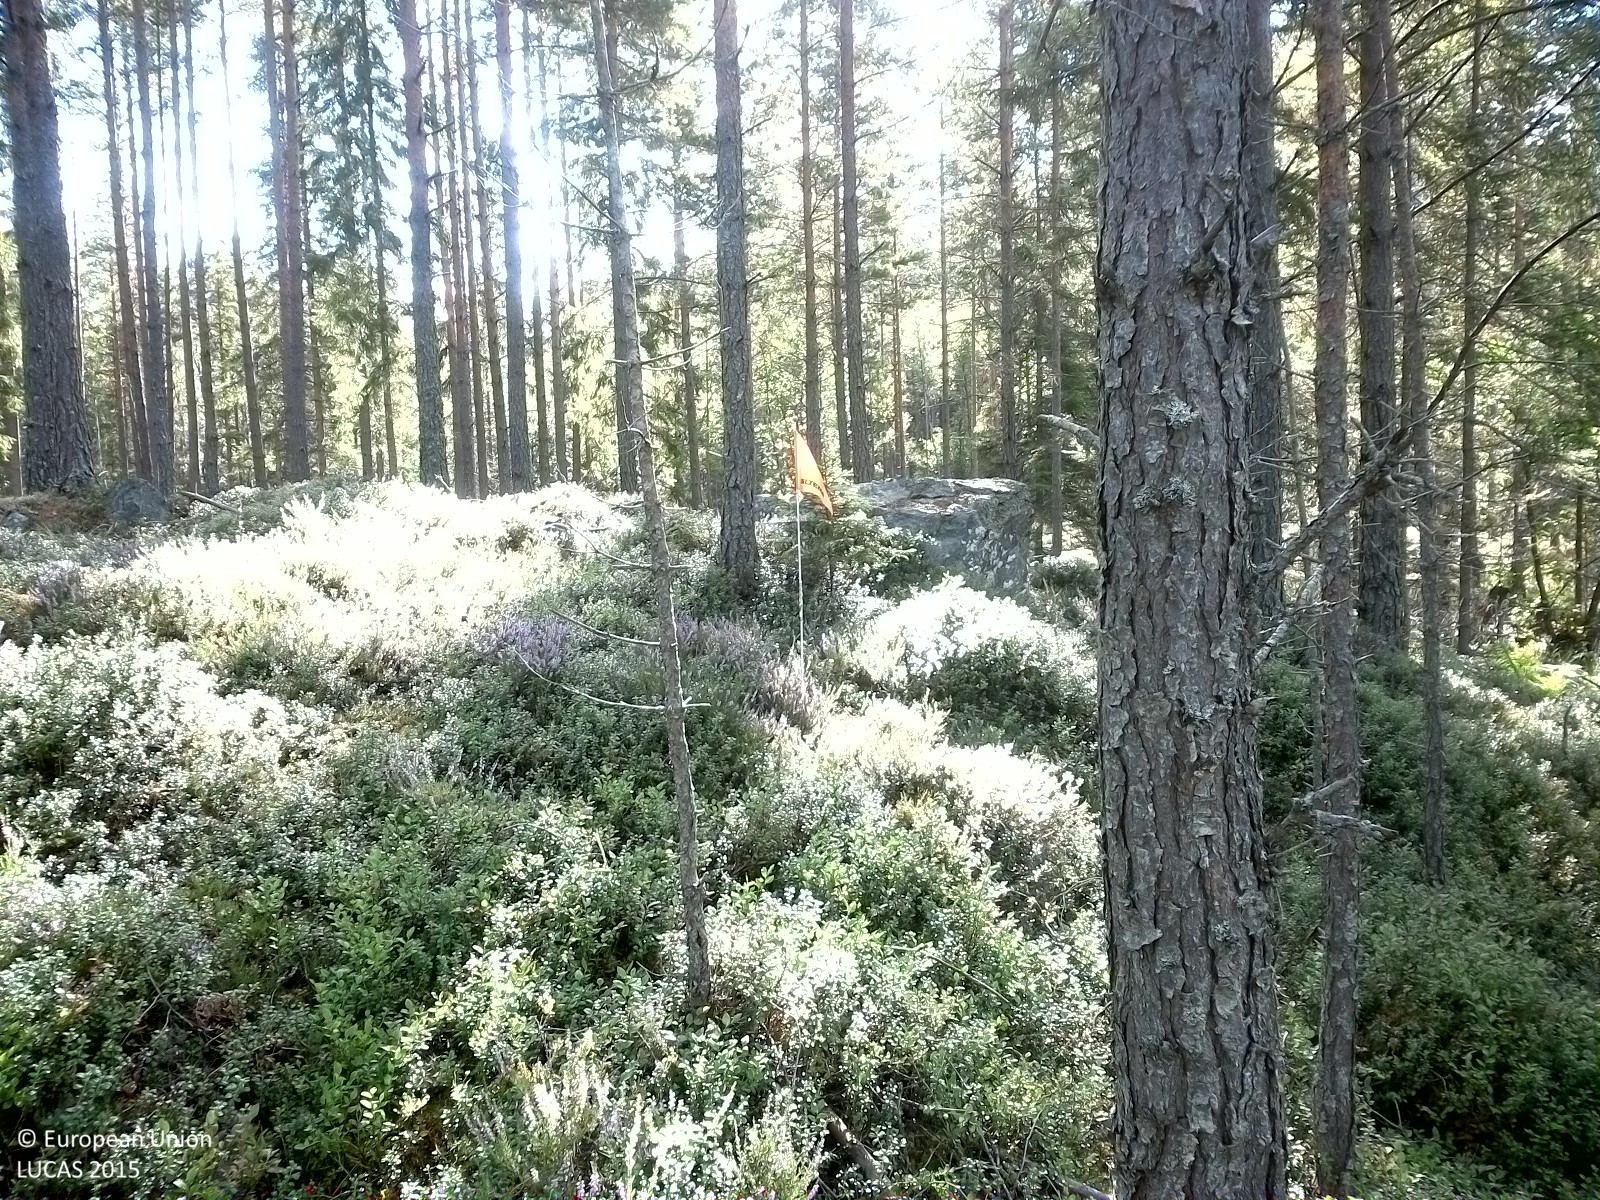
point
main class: Woodland
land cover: Pine dominated coniferous woodland
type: boreal forest
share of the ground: 25 - 50 %
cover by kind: herbaceous plants 45 %, coniferous forest trees 30 %, shrubs 15 %, lichens and mosses 10 %
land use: Forestry
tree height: > 5 m
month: August
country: SE
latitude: 58.9352
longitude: 15.5355
